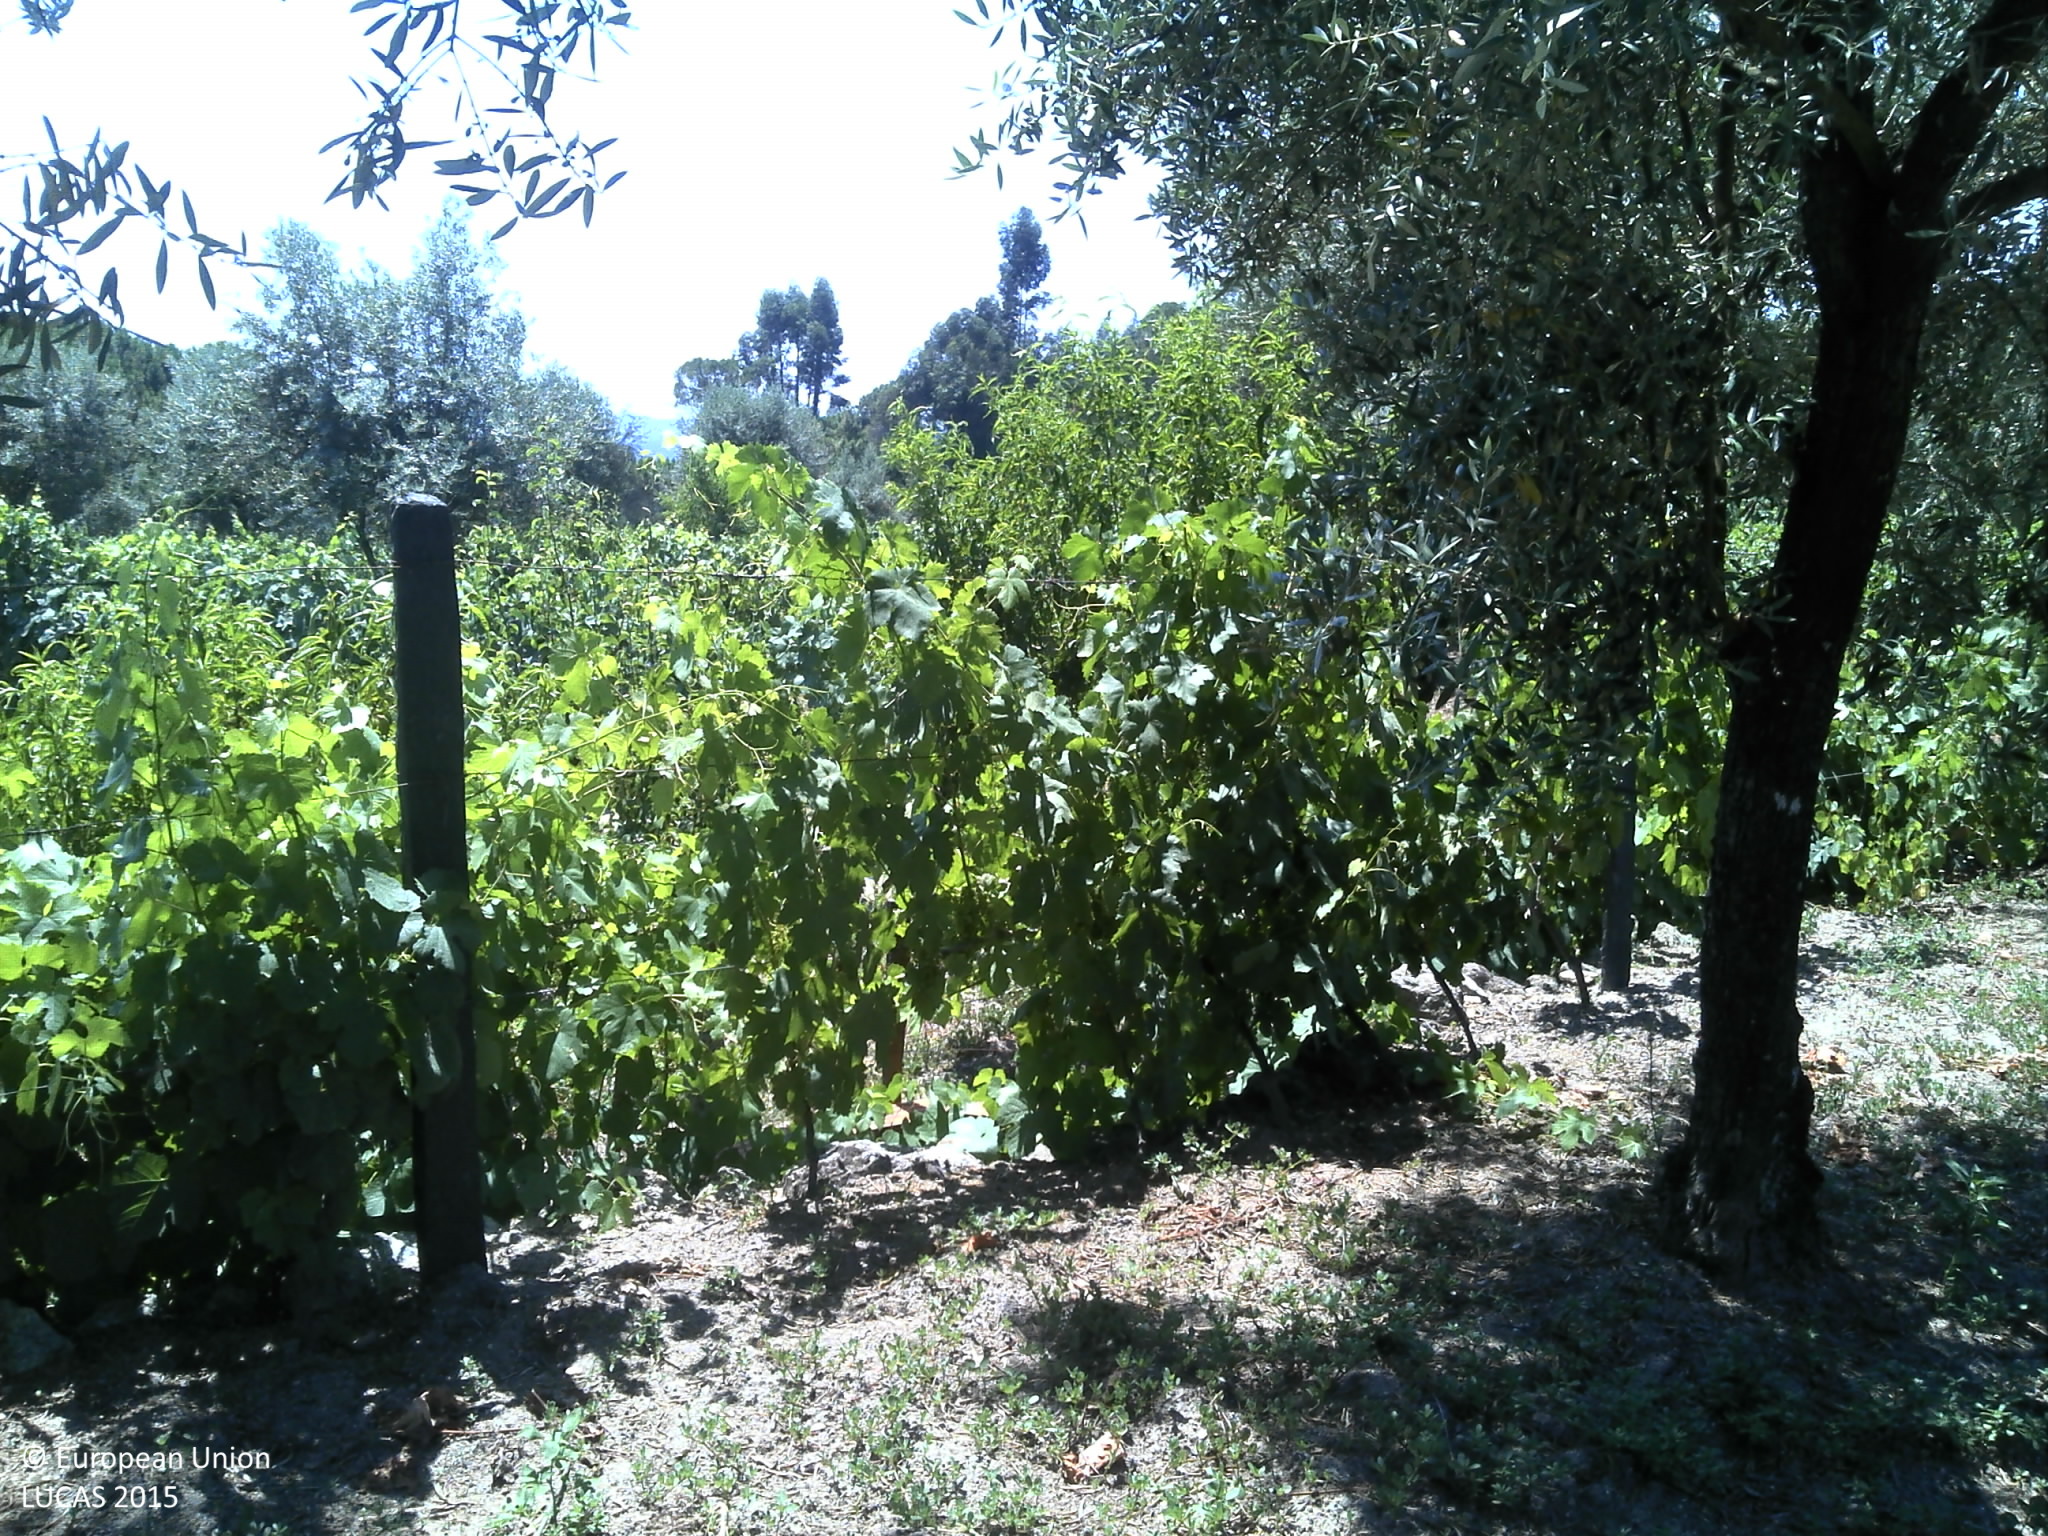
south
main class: Grassland
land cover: Grassland with sparse tree/shrub cover
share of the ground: 10 - 25 %
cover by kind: unconsolidated bare surface 70 %, herbaceous plants 25 %, broadleaved forest trees 5 %
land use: Agriculture (excluding fallow land and kitchen gardens)
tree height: > 5 m
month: June
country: PT
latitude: 40.5516
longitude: -7.9671
